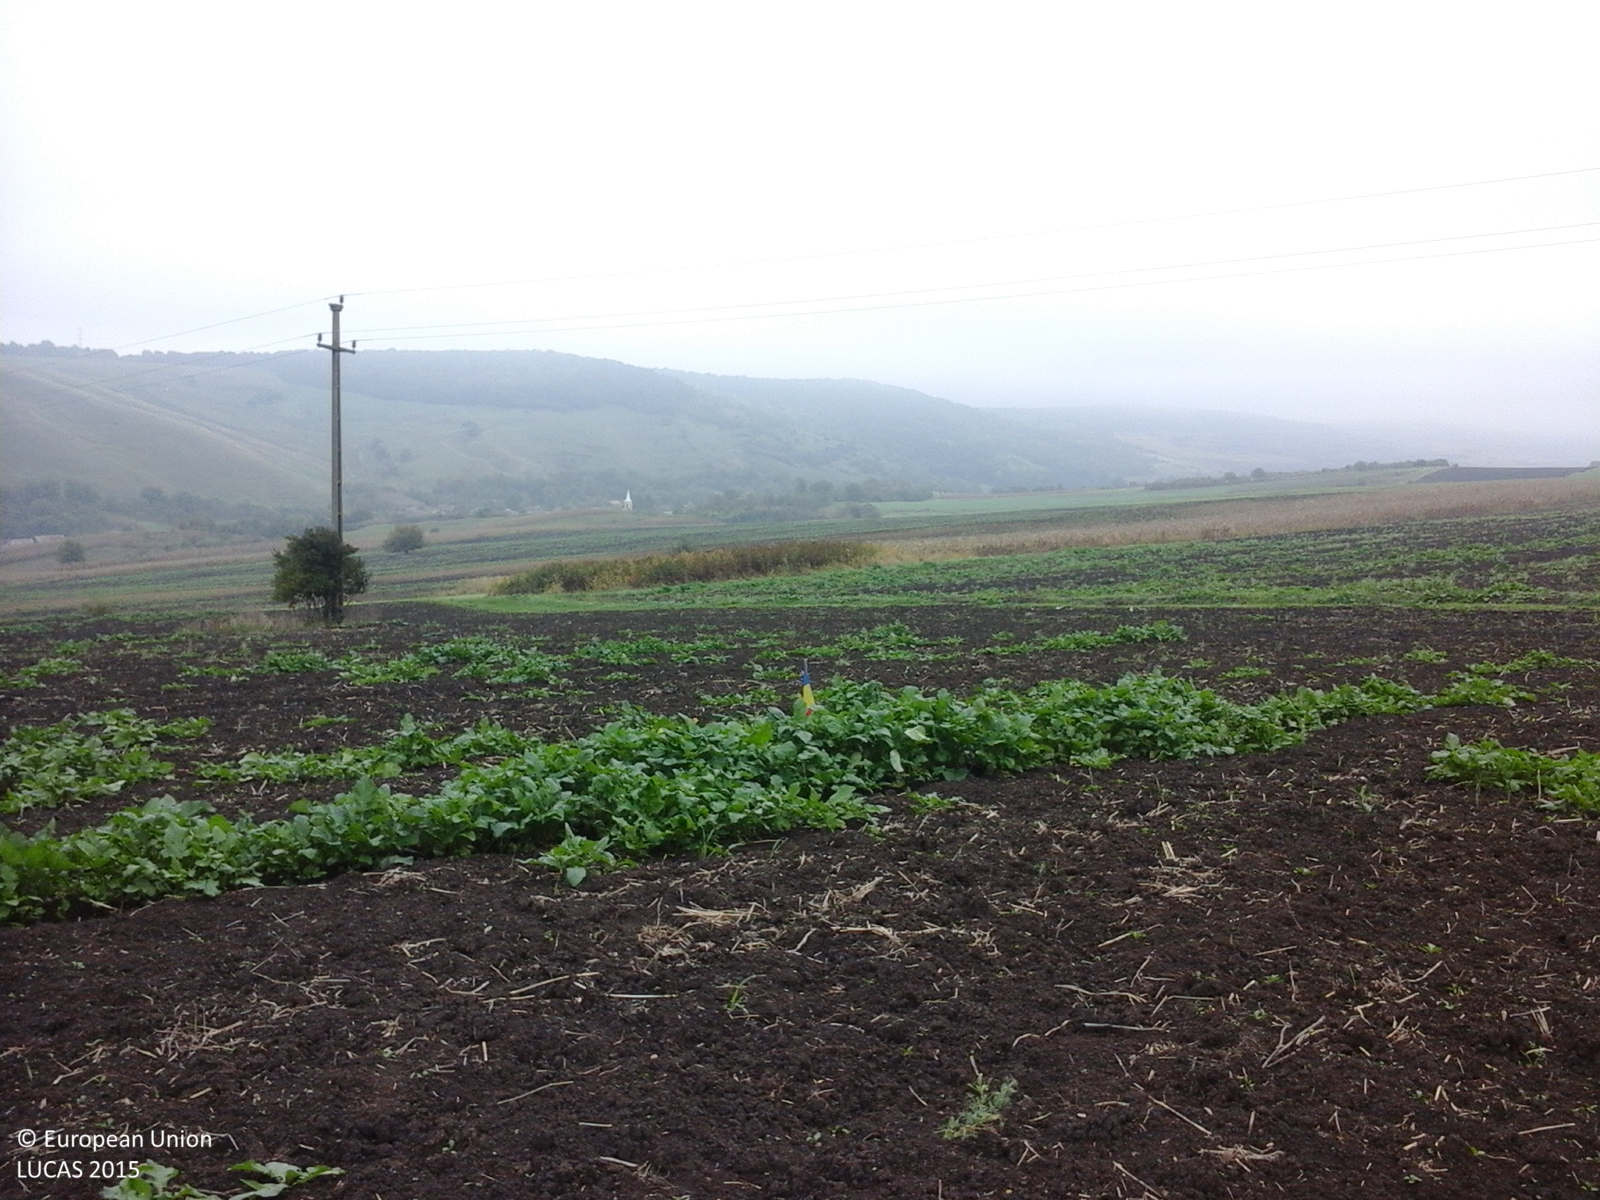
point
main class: Cropland
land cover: Rape and turnip rape
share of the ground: 50 - 75 %
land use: Agriculture (excluding fallow land and kitchen gardens)
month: October
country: RO
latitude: 46.4006
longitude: 24.2186
